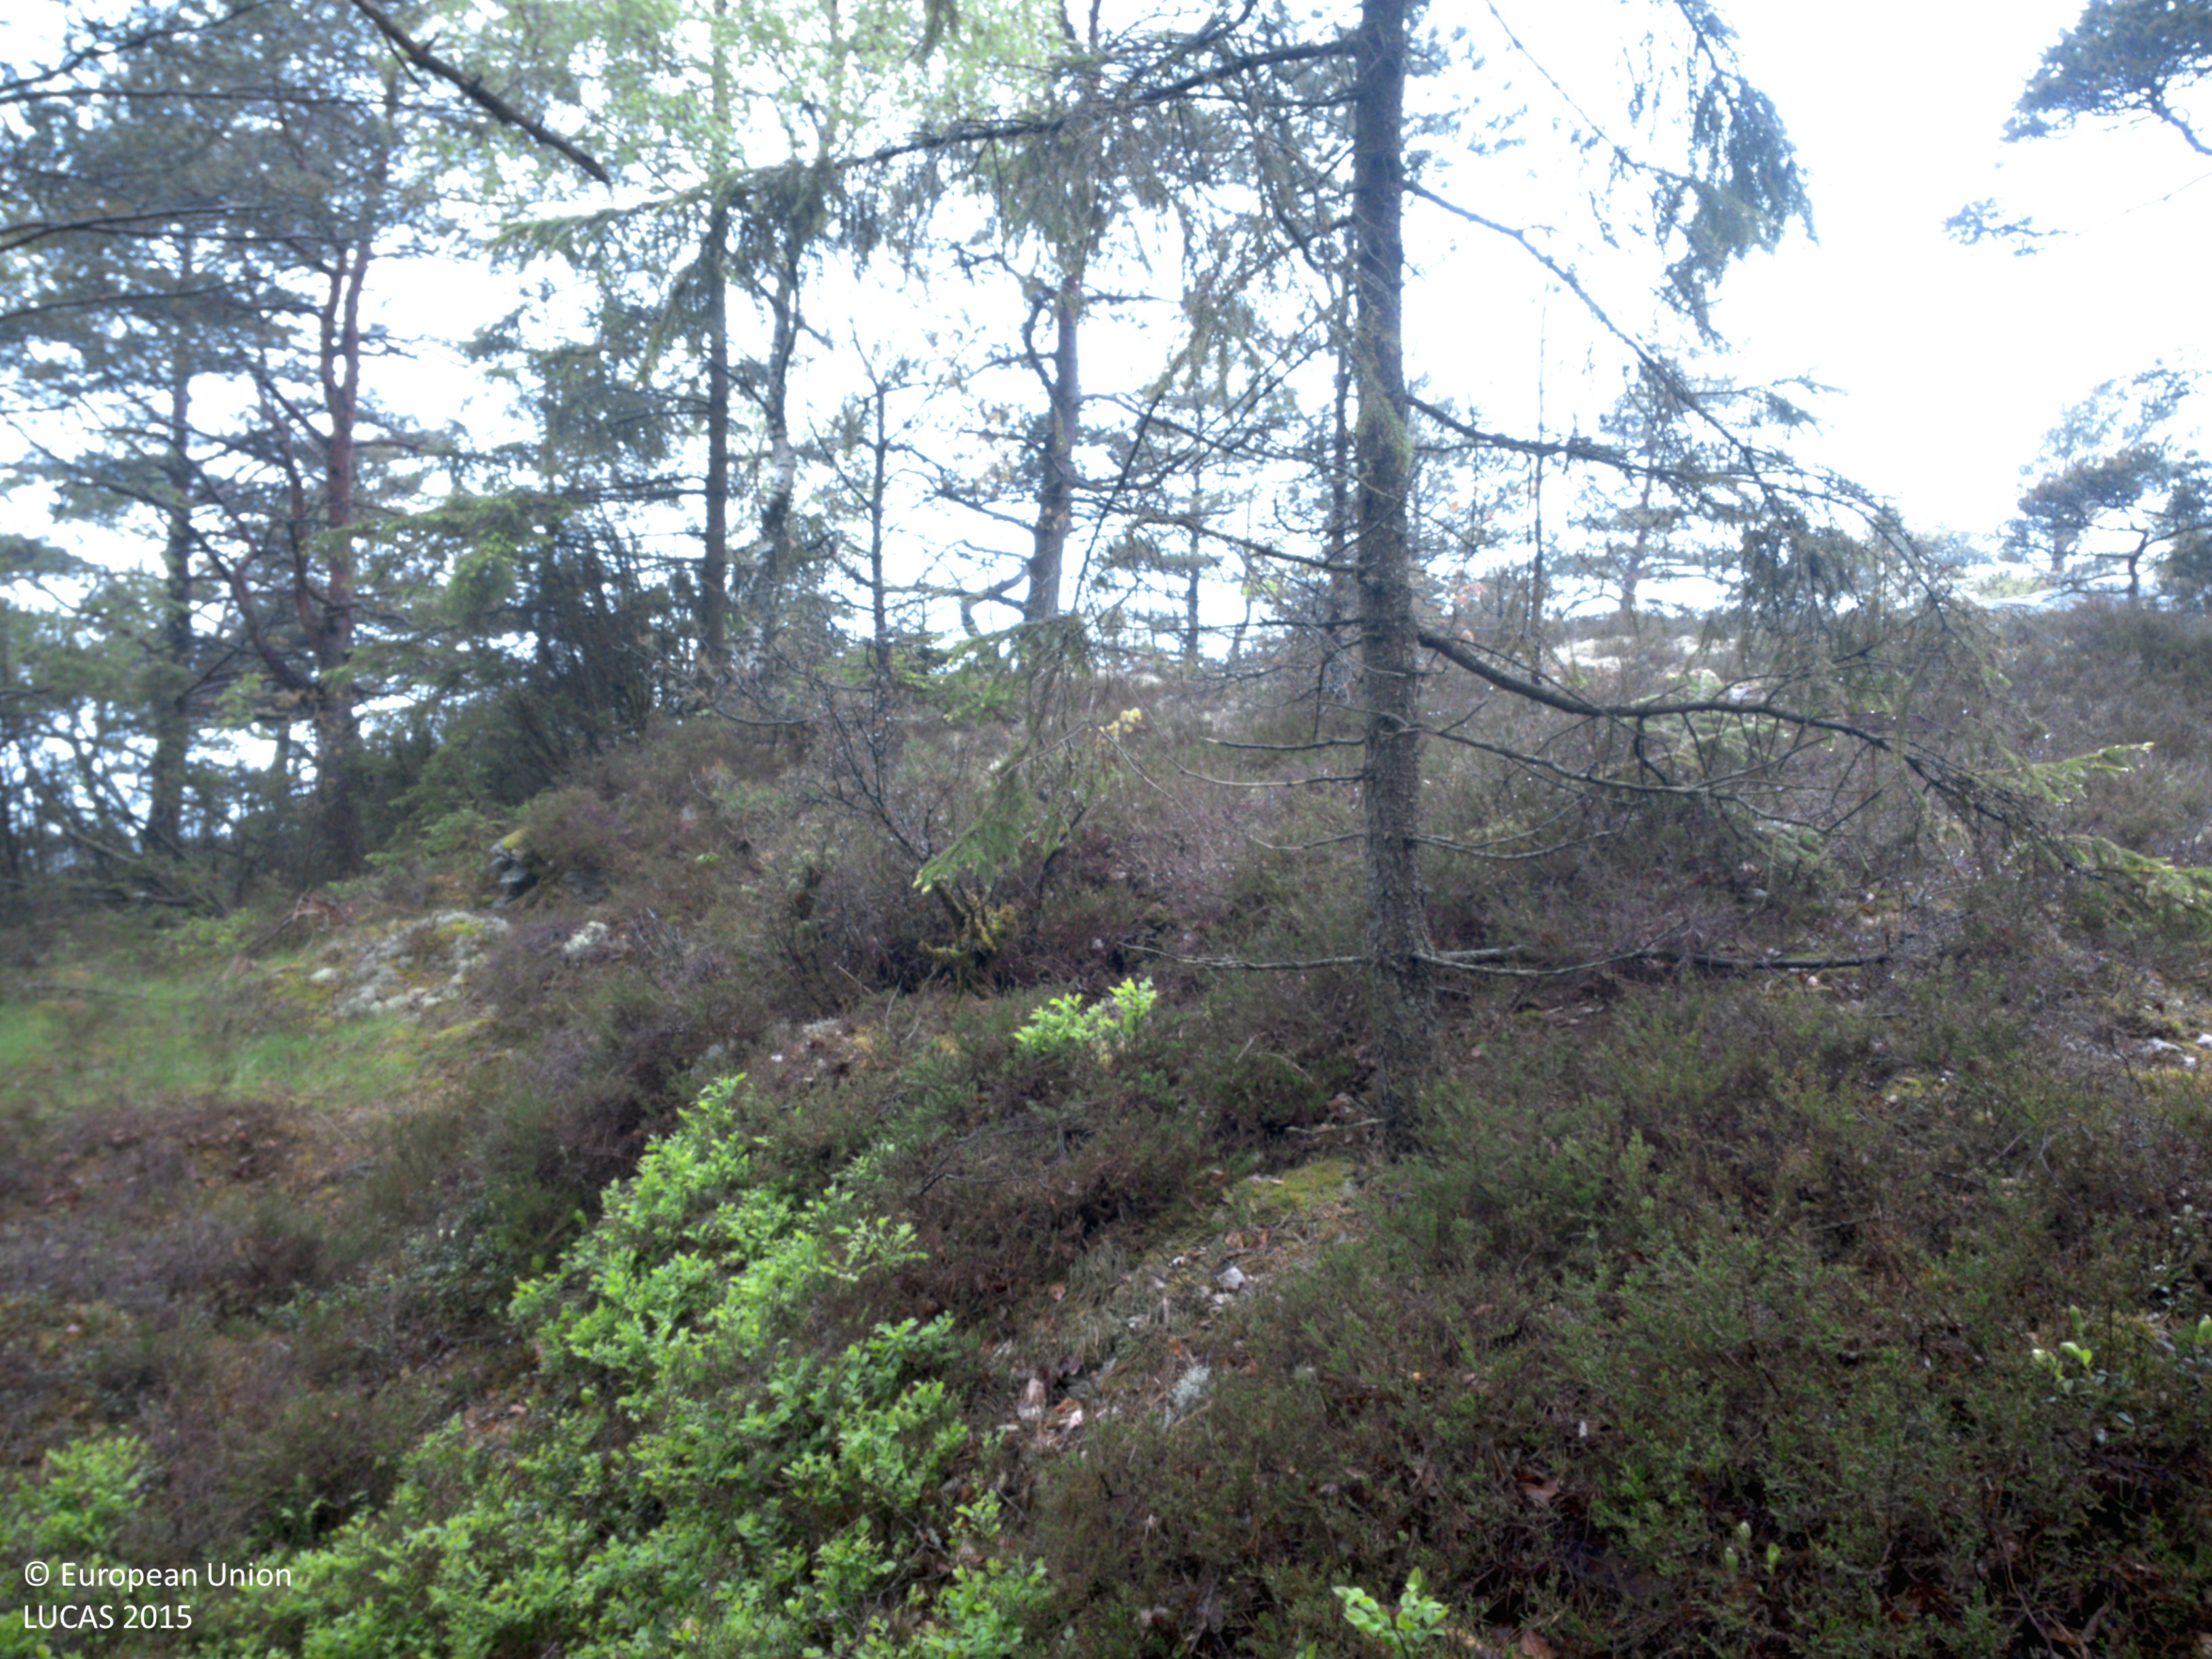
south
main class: Woodland
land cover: Spruce dominated mixed woodland
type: boreal forest
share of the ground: > 75 %
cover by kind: coniferous forest trees 60 %, broadleaved forest trees 30 %, herbaceous plants 10 %
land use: Forestry
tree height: > 5 m
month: May
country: SE
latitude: 58.3536
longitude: 11.6201
